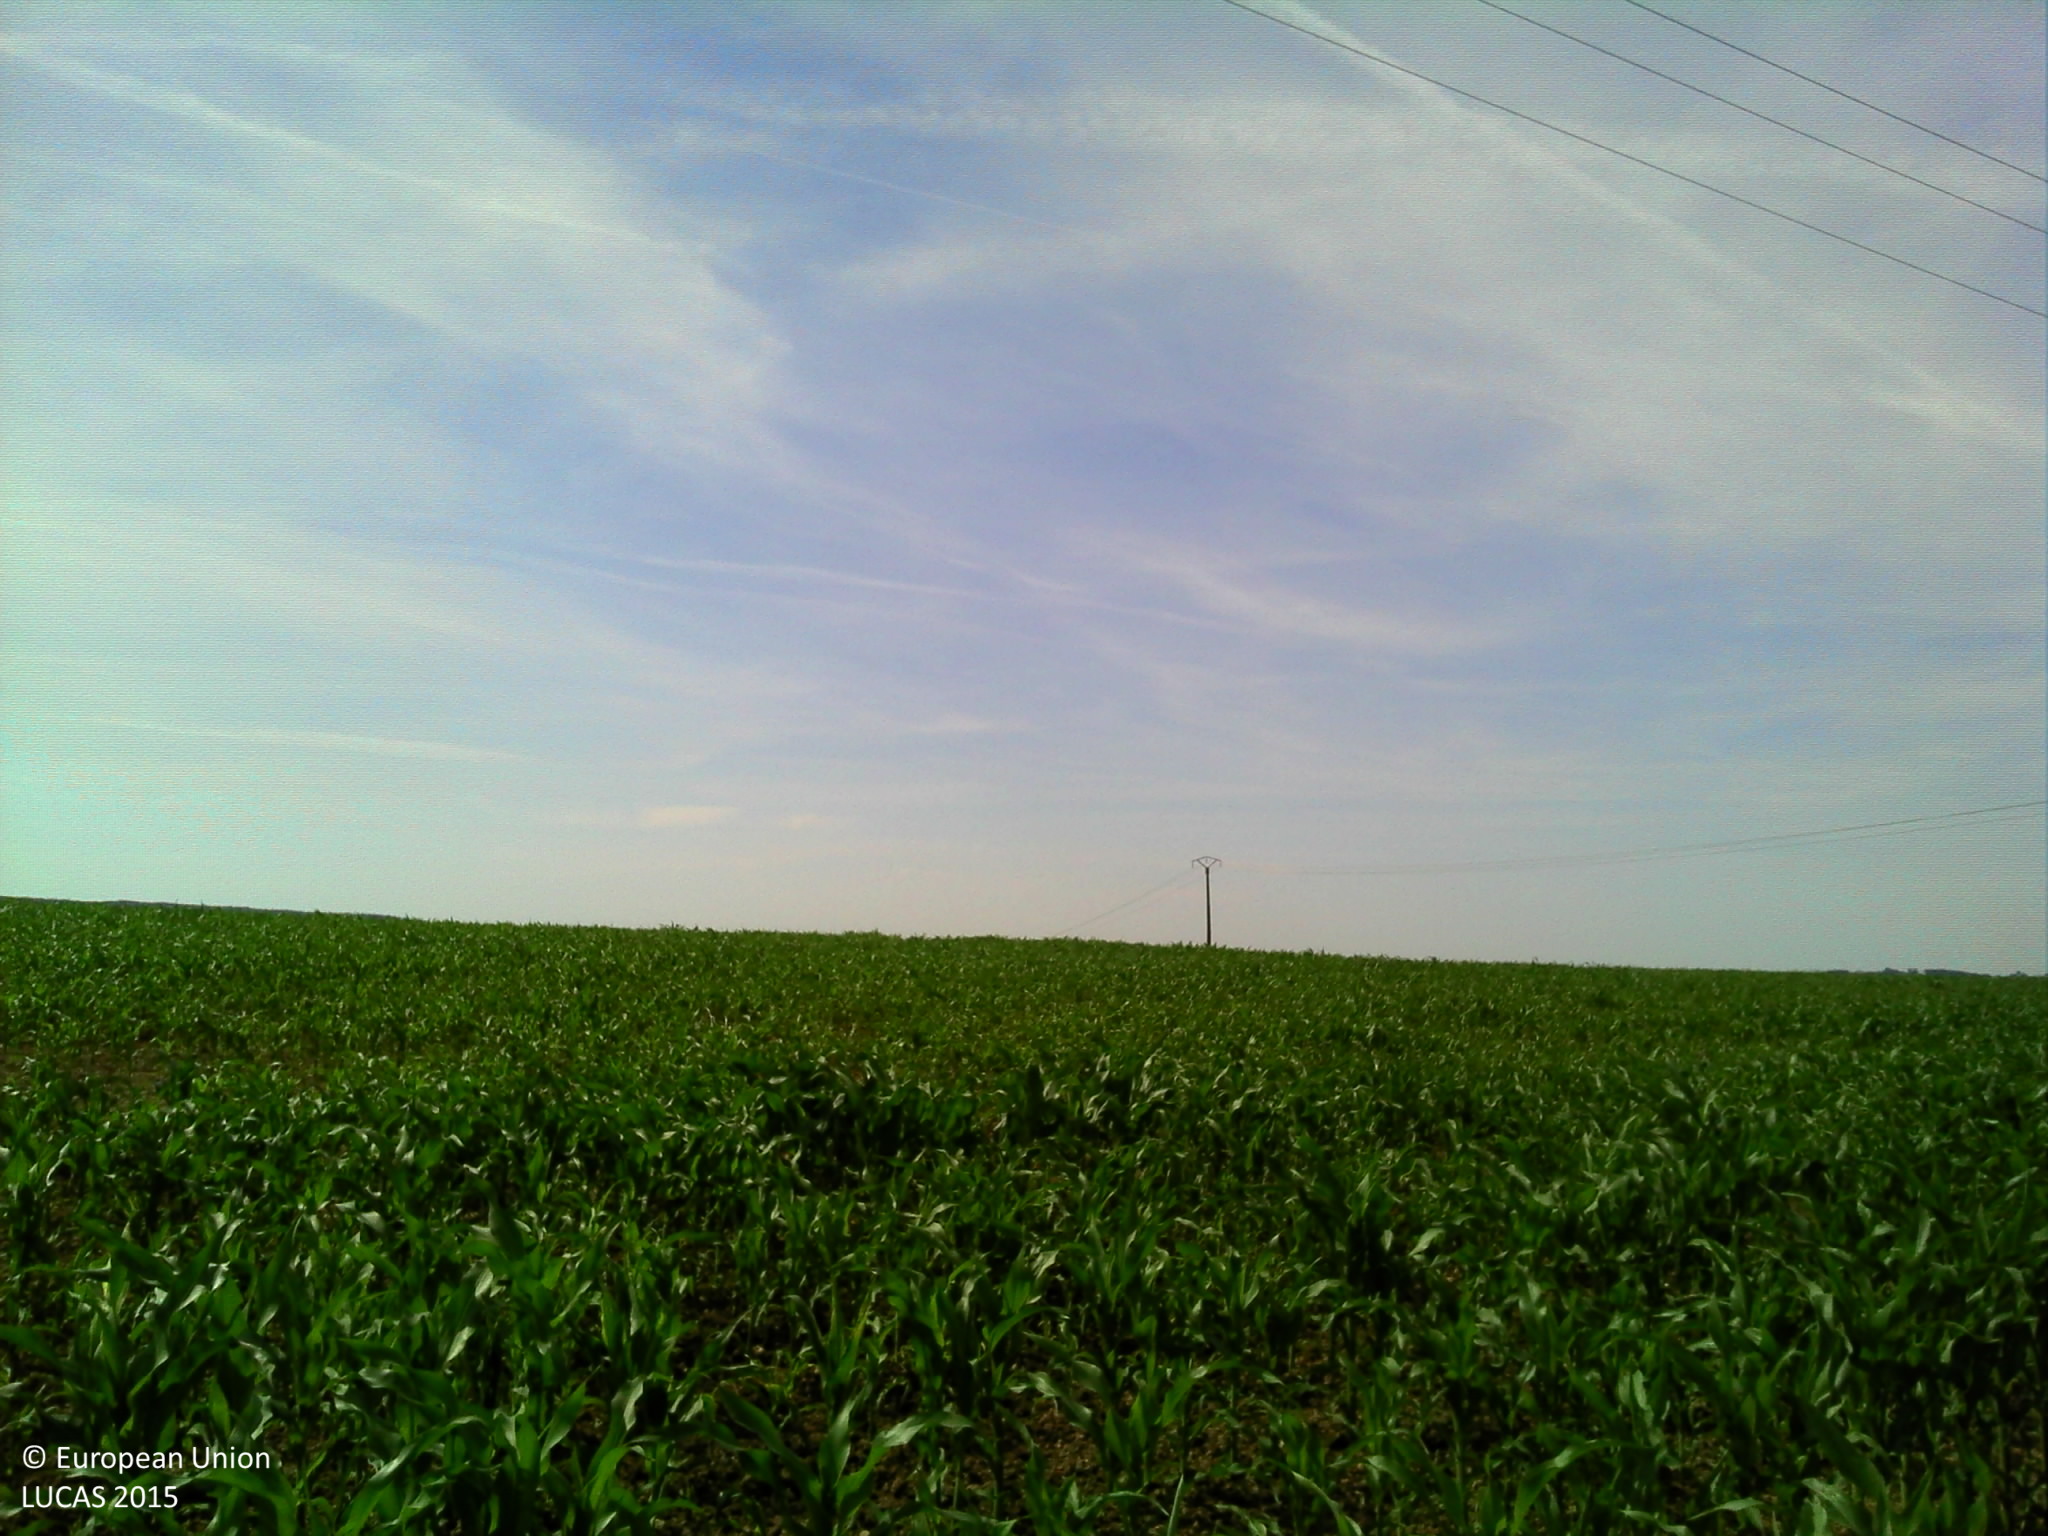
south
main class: Cropland
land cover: Maize
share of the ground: 25 - 50 %
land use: Agriculture (excluding fallow land and kitchen gardens)
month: June
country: FR
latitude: 48.4335
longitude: 0.1459
